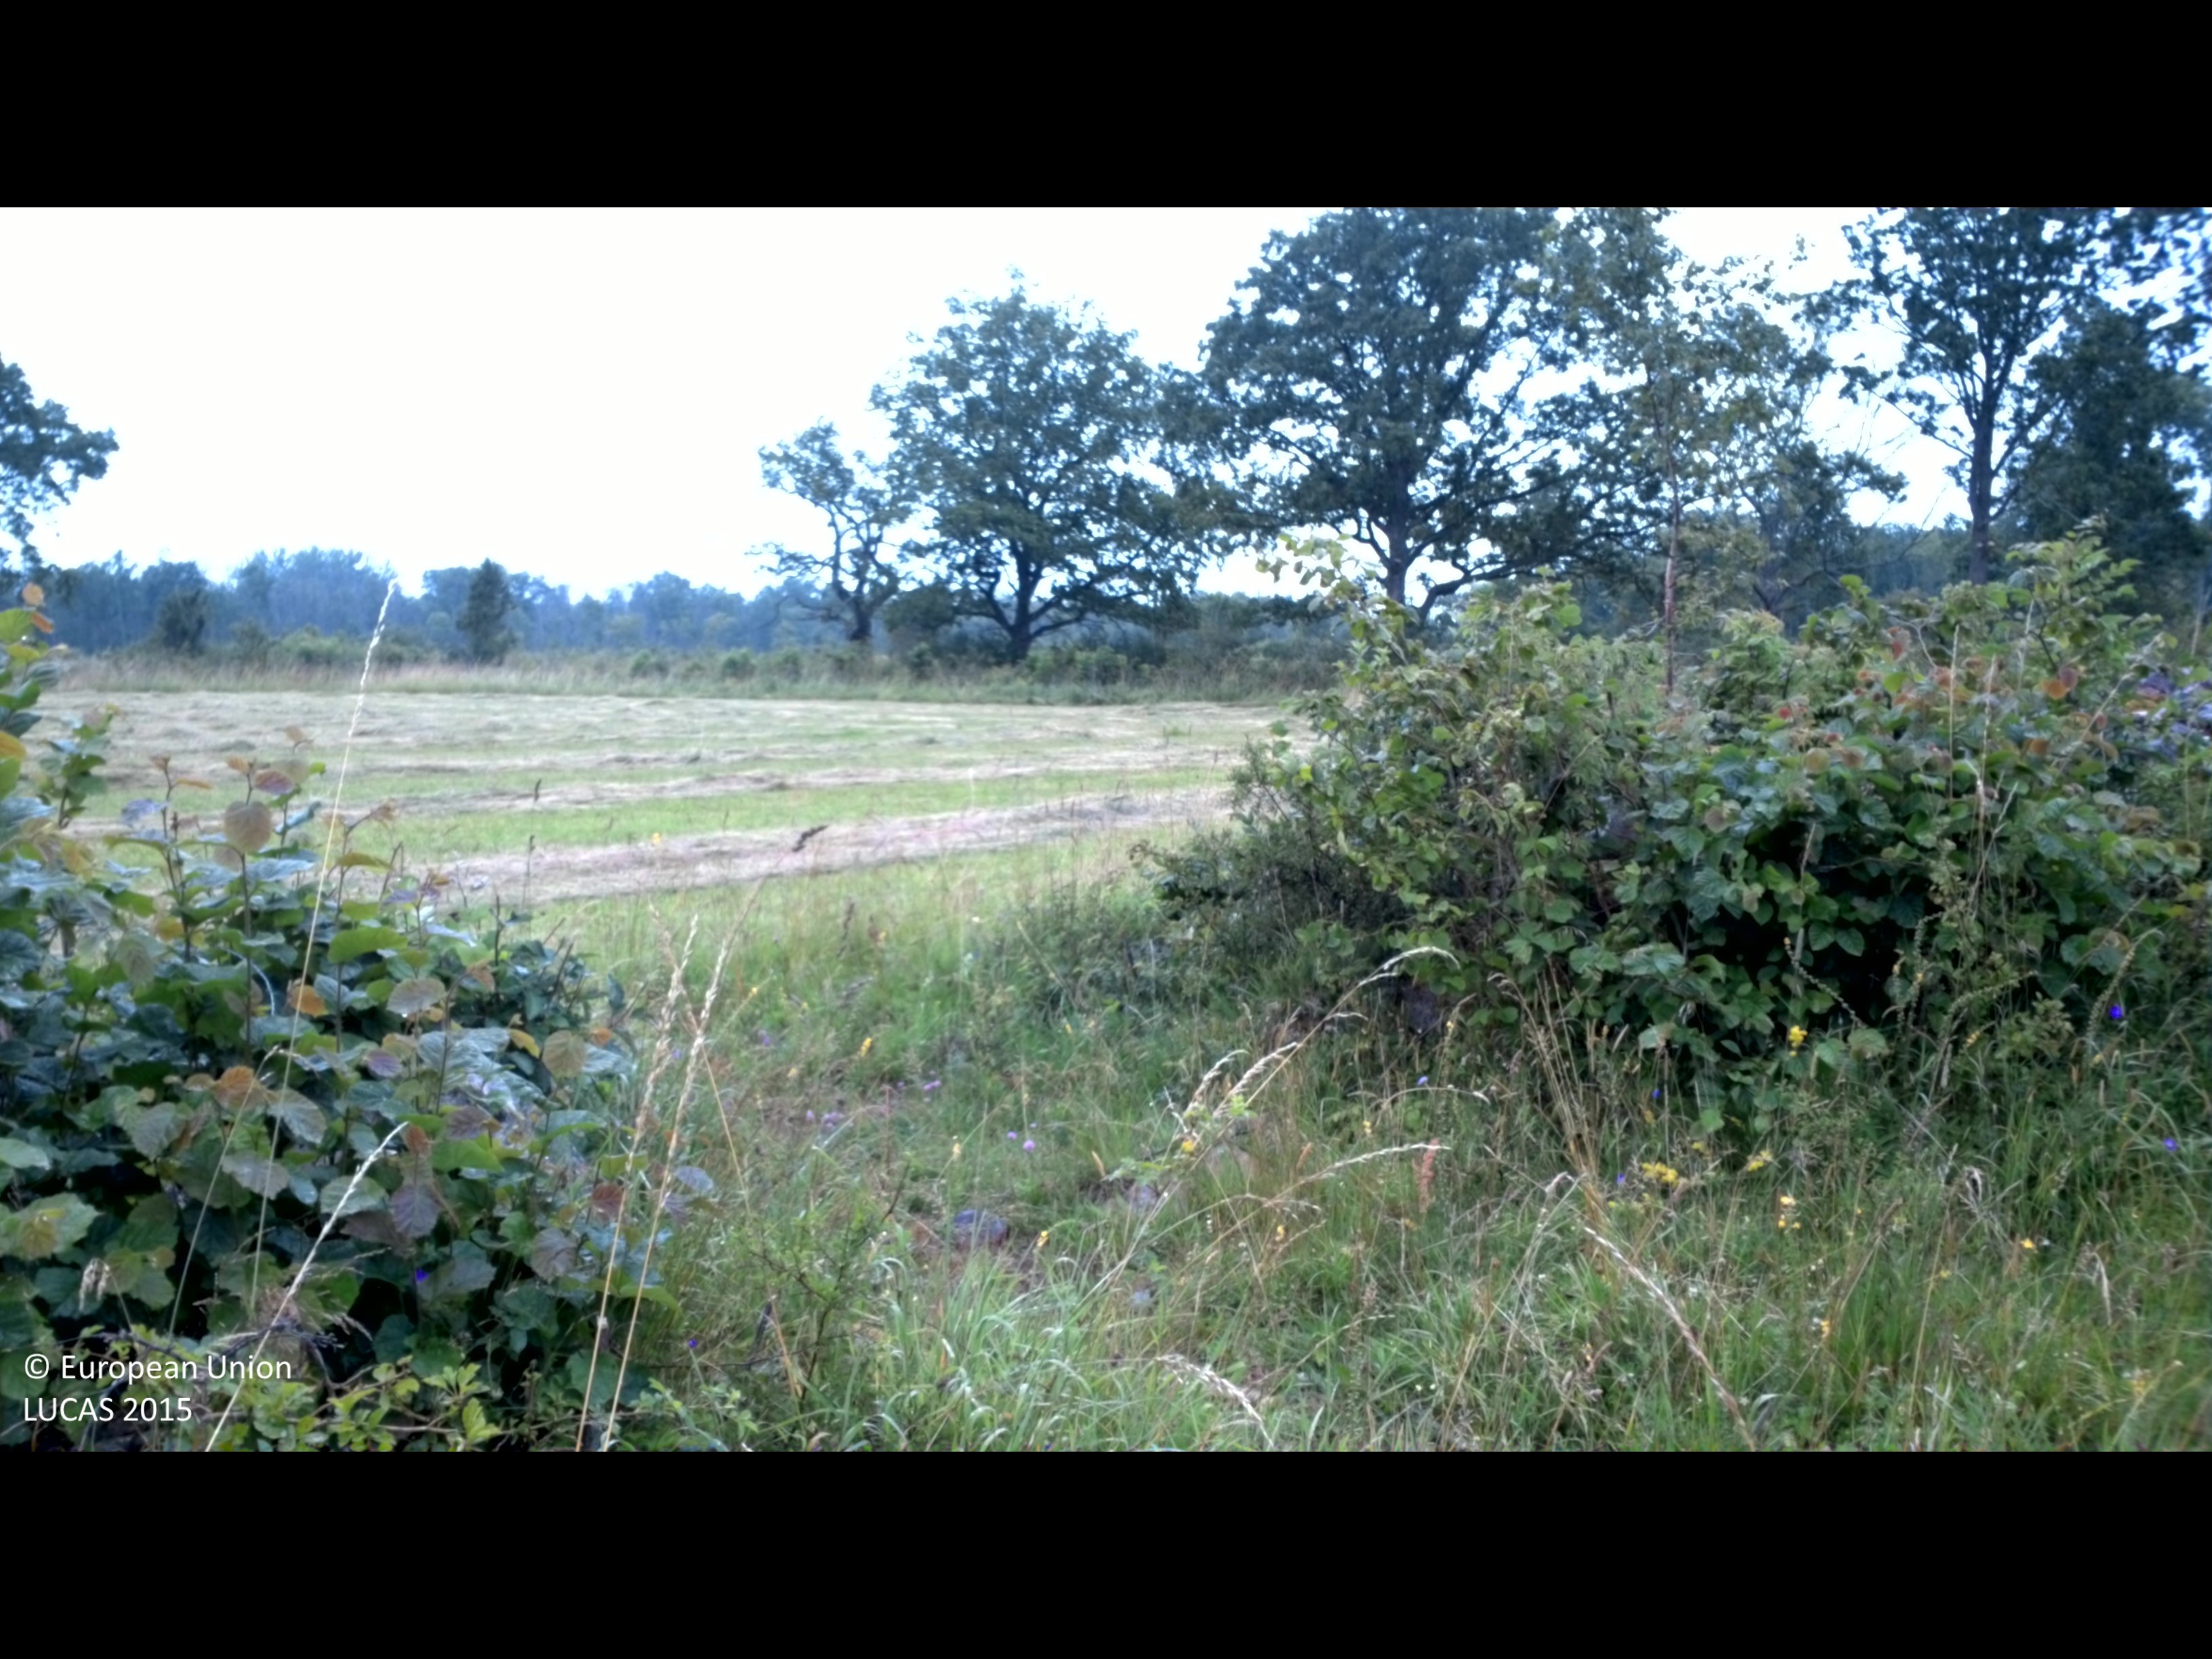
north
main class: Shrubland
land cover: Shrubland with sparse tree cover
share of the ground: > 75 %
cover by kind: shrubs 85 %, herbaceous plants 10 %, broadleaved forest trees 5 %
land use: Fallow land
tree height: > 5 m
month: July
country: SE
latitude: 56.7190
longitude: 16.6520
